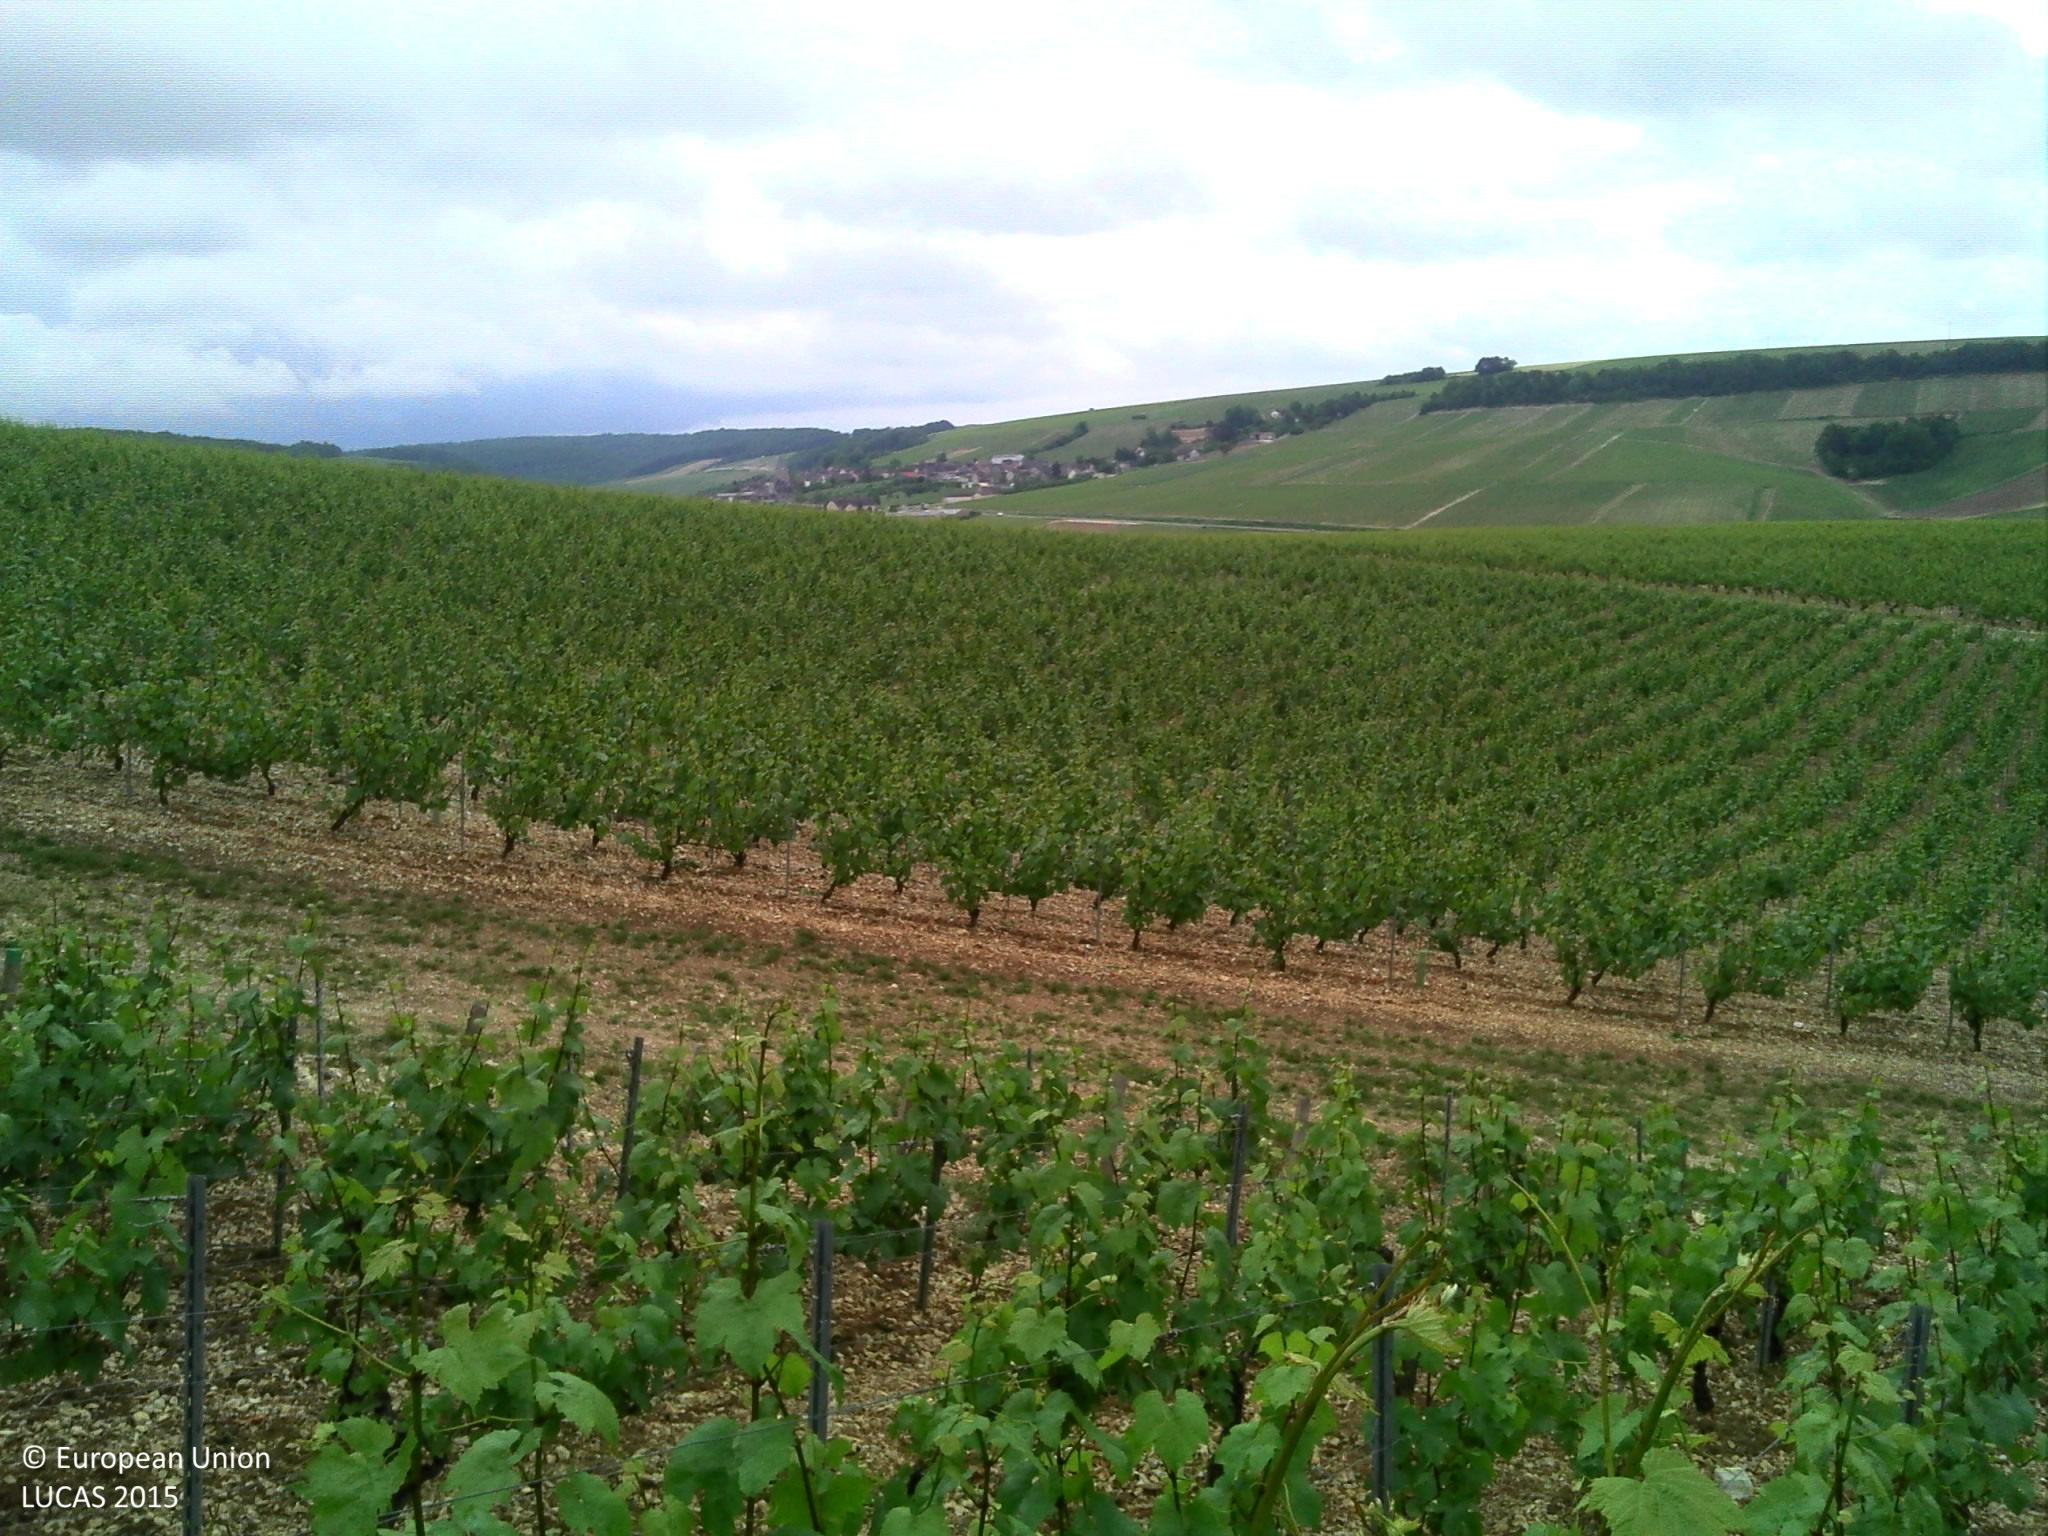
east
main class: Cropland
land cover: Vineyards
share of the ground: > 75 %
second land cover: Other bare soil
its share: > 75 %
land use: Agriculture (excluding fallow land and kitchen gardens)
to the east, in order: Vineyards; Other bare soil; Tracks; Other bare soil; Vineyards; Grass margins; Vineyards; Grass margins; Tracks; Grass margins; Vineyards; Grass margins; Tracks; Vineyards
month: May
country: FR
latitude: 47.8166
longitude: 3.8397
